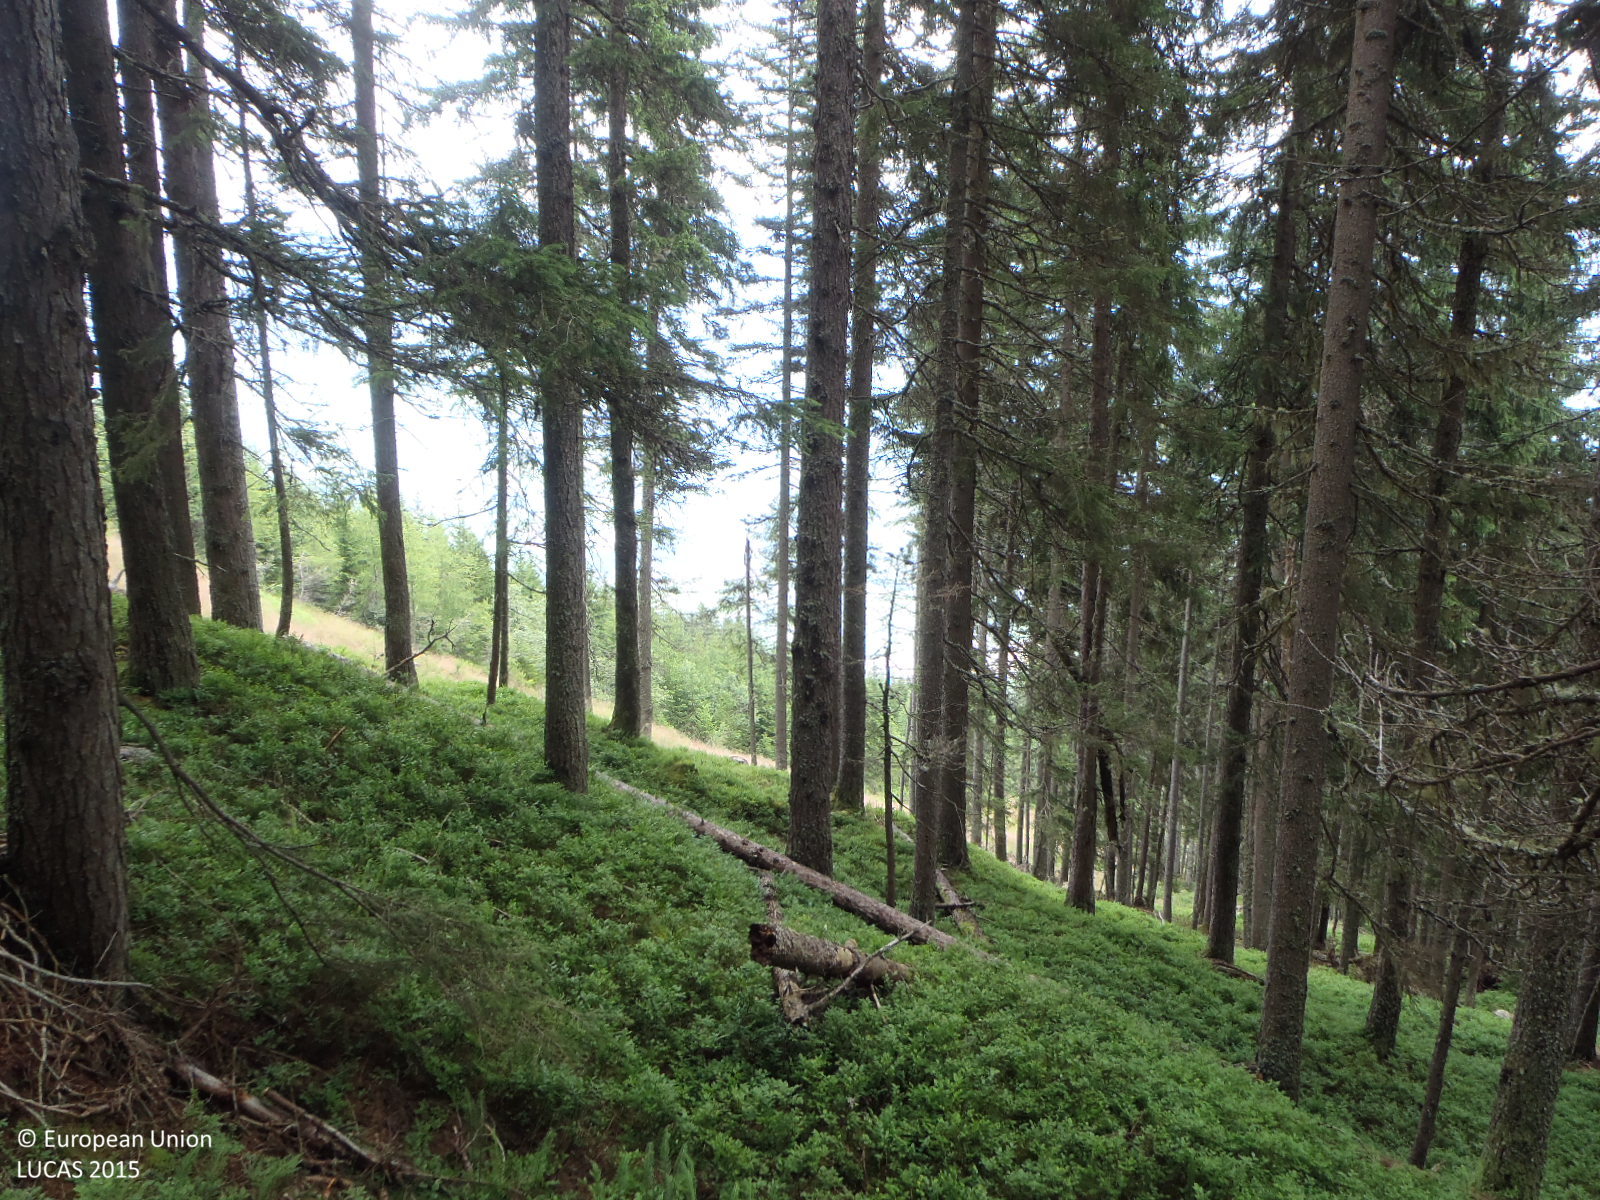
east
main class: Woodland
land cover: Spruce dominated coniferous woodland
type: alpine coniferous forest
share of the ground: > 75 %
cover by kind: coniferous forest trees 90 %, shrubs 10 %
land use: Forestry
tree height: > 5 m
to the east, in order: Spruce dominated coniferous woodland; Grassland with sparse tree/shrub cover; Spruce dominated coniferous woodland; Tracks; Shrubland with sparse tree cover; Spruce dominated coniferous woodland
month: July
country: AT
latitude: 47.3445
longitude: 11.8119
